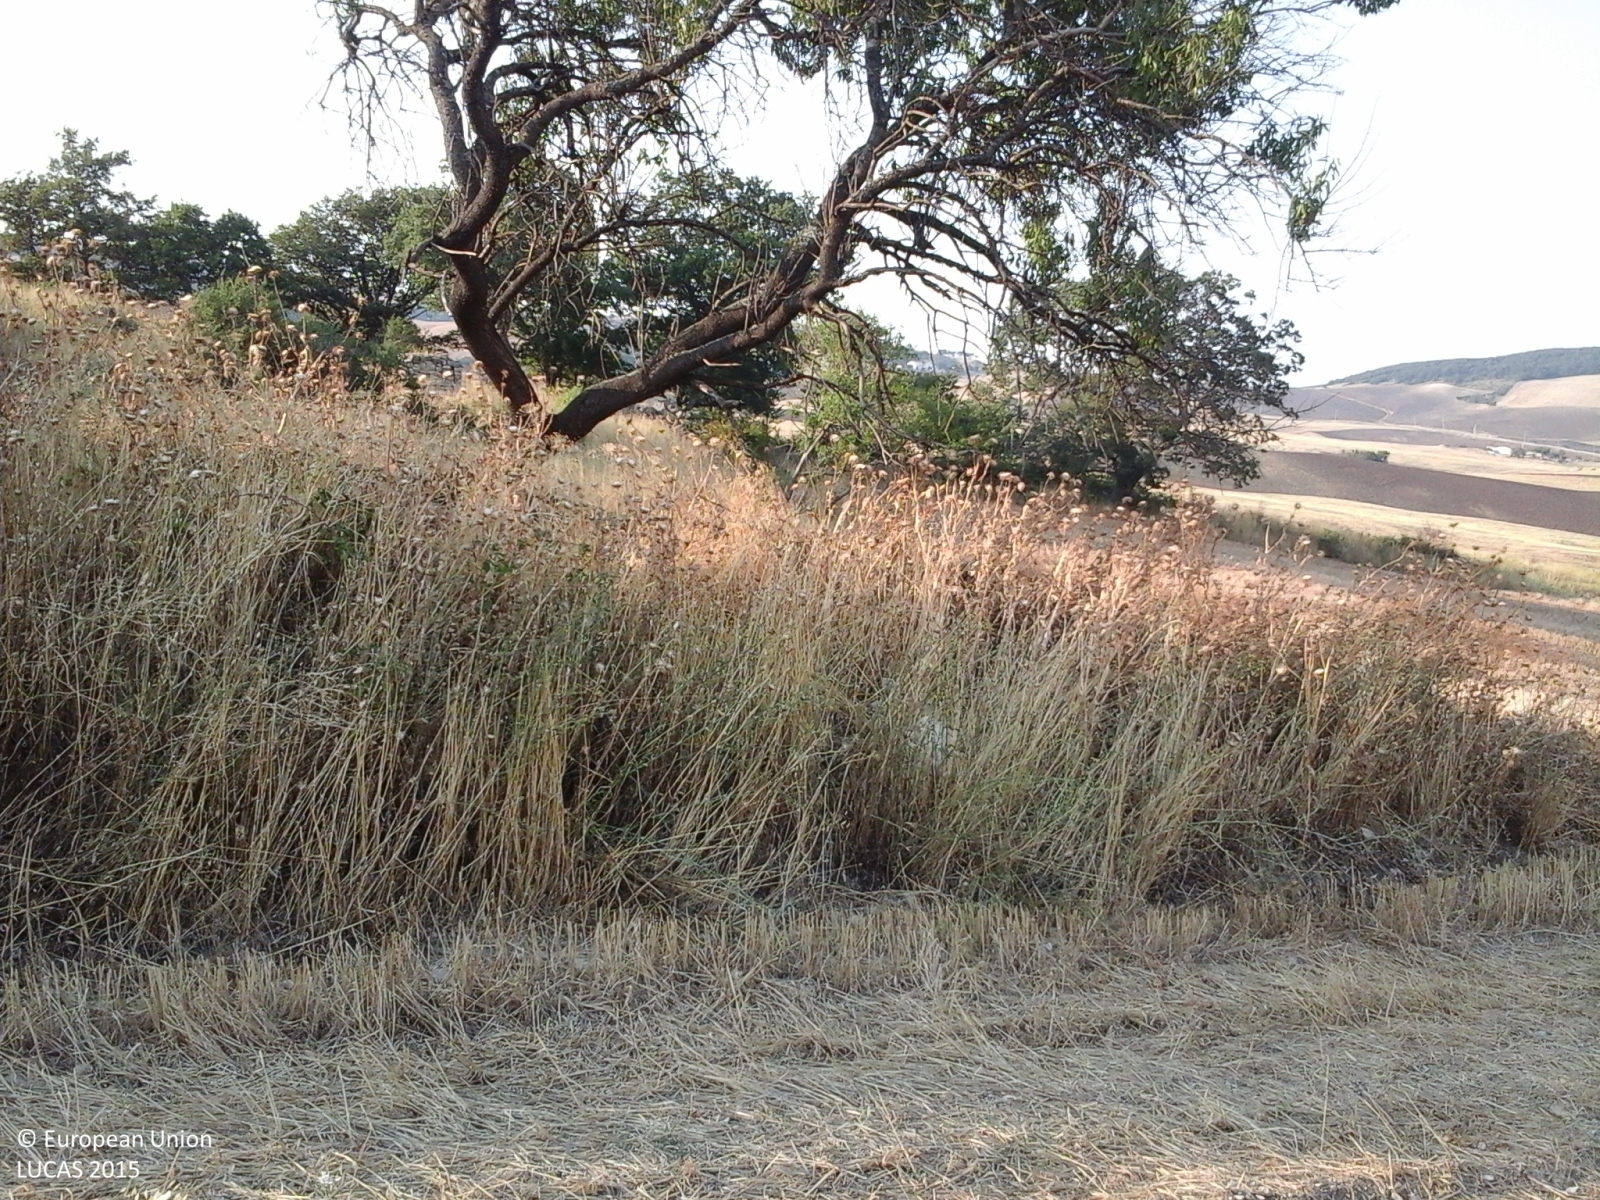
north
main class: Cropland
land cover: Durum wheat
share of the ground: > 75 %
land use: Agriculture (excluding fallow land and kitchen gardens)
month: August
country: IT
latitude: 41.4013
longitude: 15.1376
